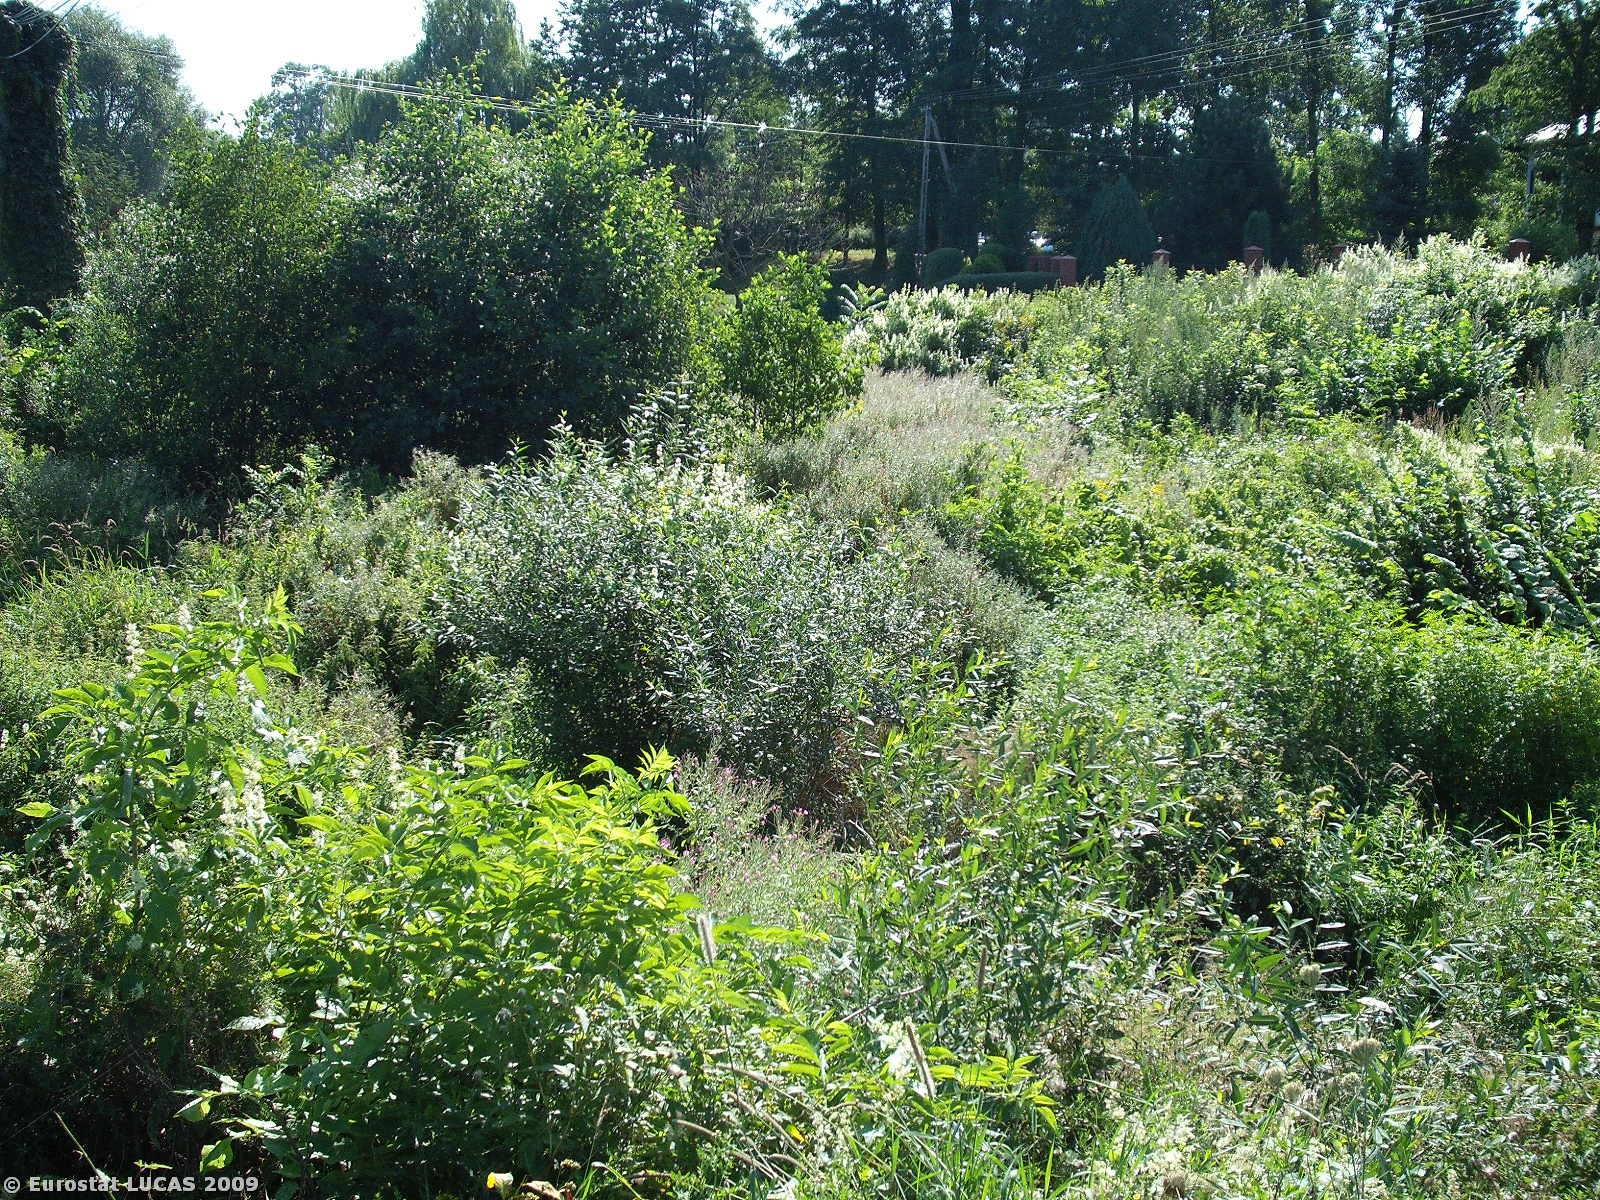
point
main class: Shrubland
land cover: Shrubland with sparse tree cover
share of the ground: > 75 %
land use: Unused
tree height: < 5 m
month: August
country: PL
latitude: 50.1926
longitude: 22.0913
